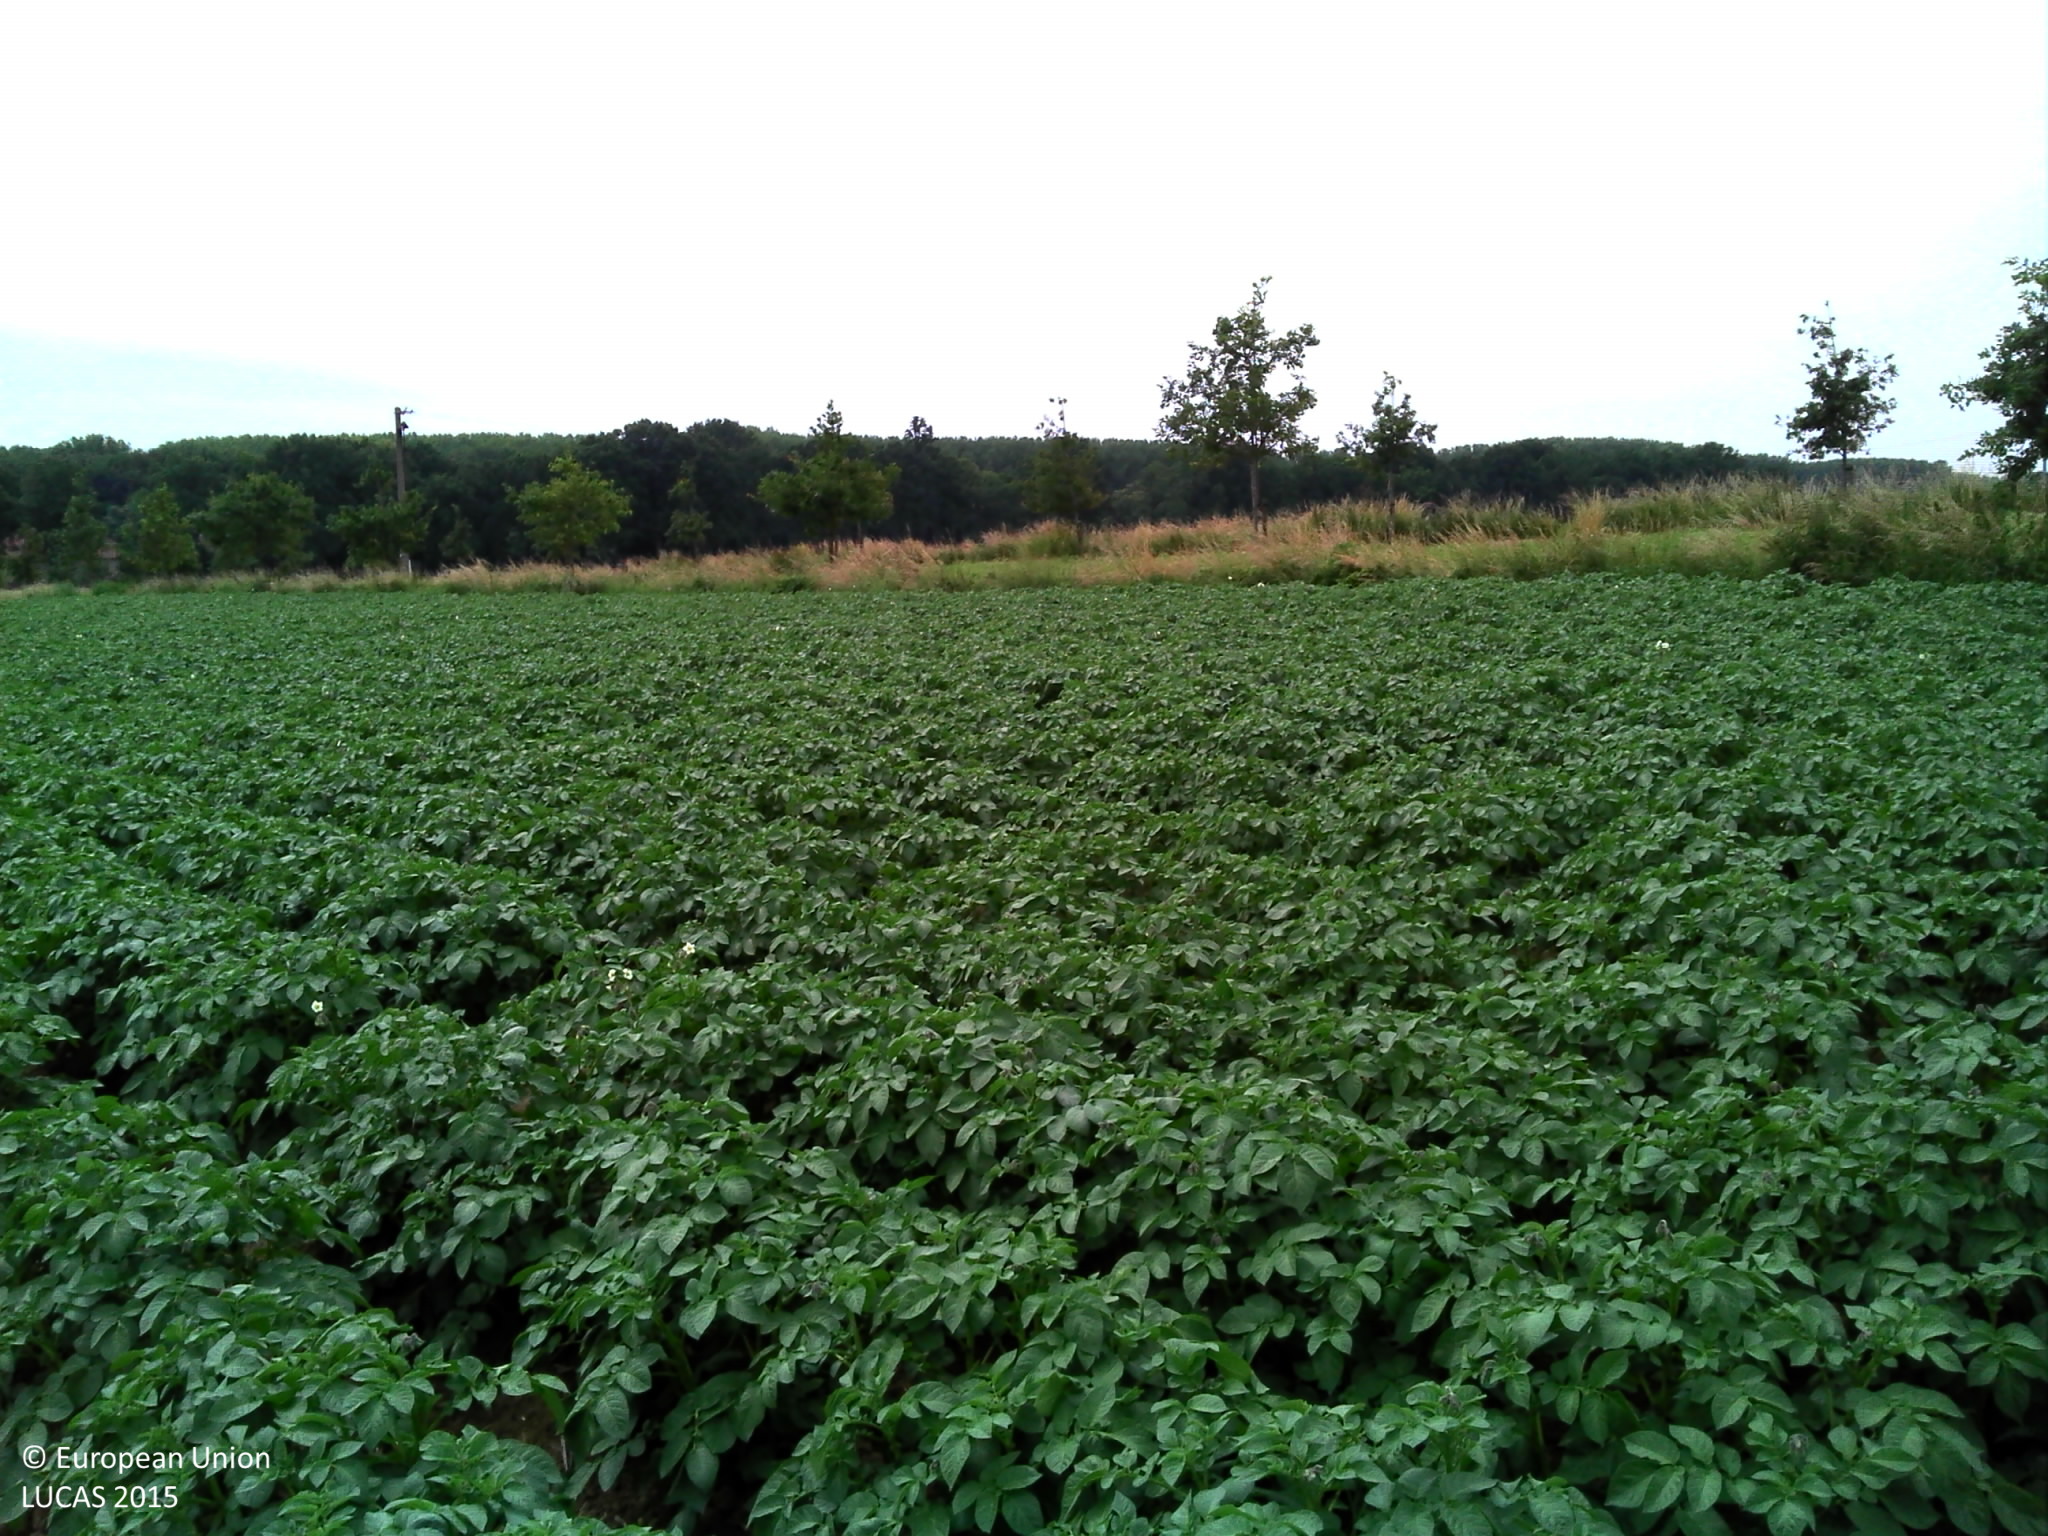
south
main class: Cropland
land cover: Potatoes
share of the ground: > 75 %
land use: Agriculture (excluding fallow land and kitchen gardens)
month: June
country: BE
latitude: 50.6040
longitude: 3.6771
